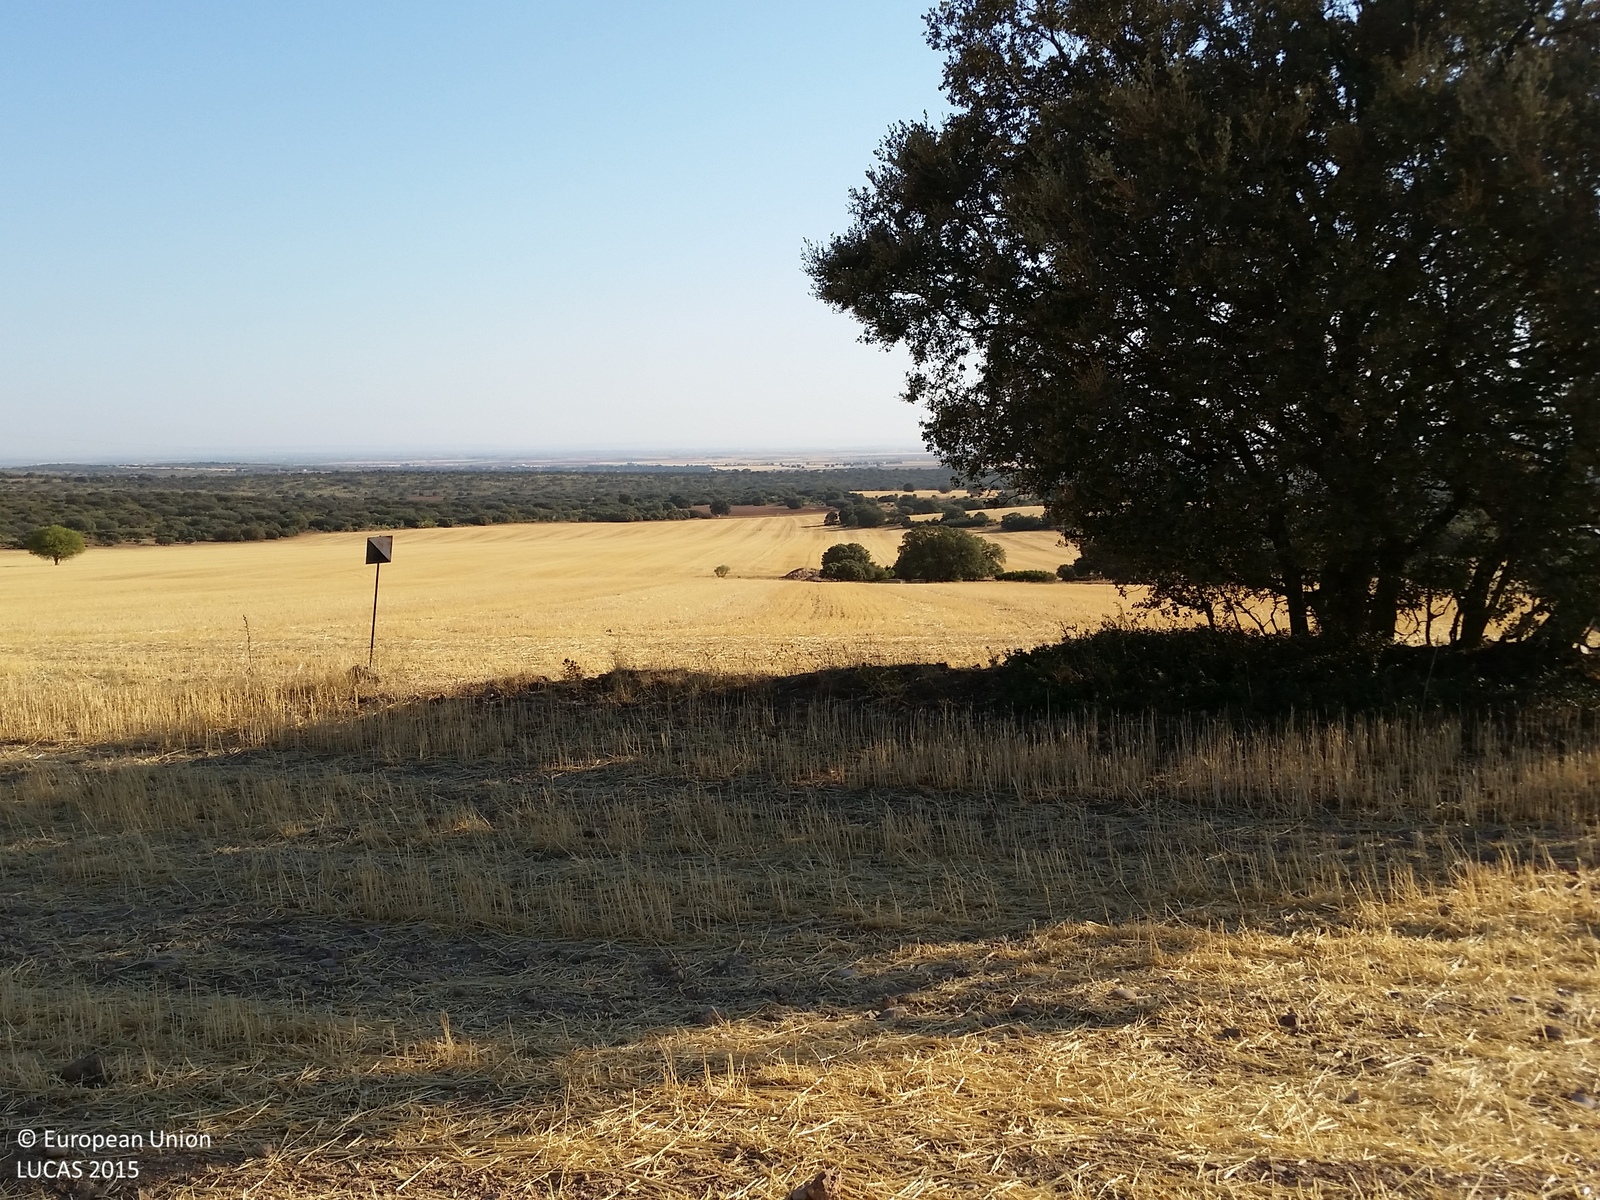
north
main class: Cropland
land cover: Common wheat
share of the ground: < 10 %
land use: Agriculture (excluding fallow land and kitchen gardens)
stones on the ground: 10 - 25 %
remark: Harvested field
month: July
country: ES
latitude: 39.0591
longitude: -2.6620
